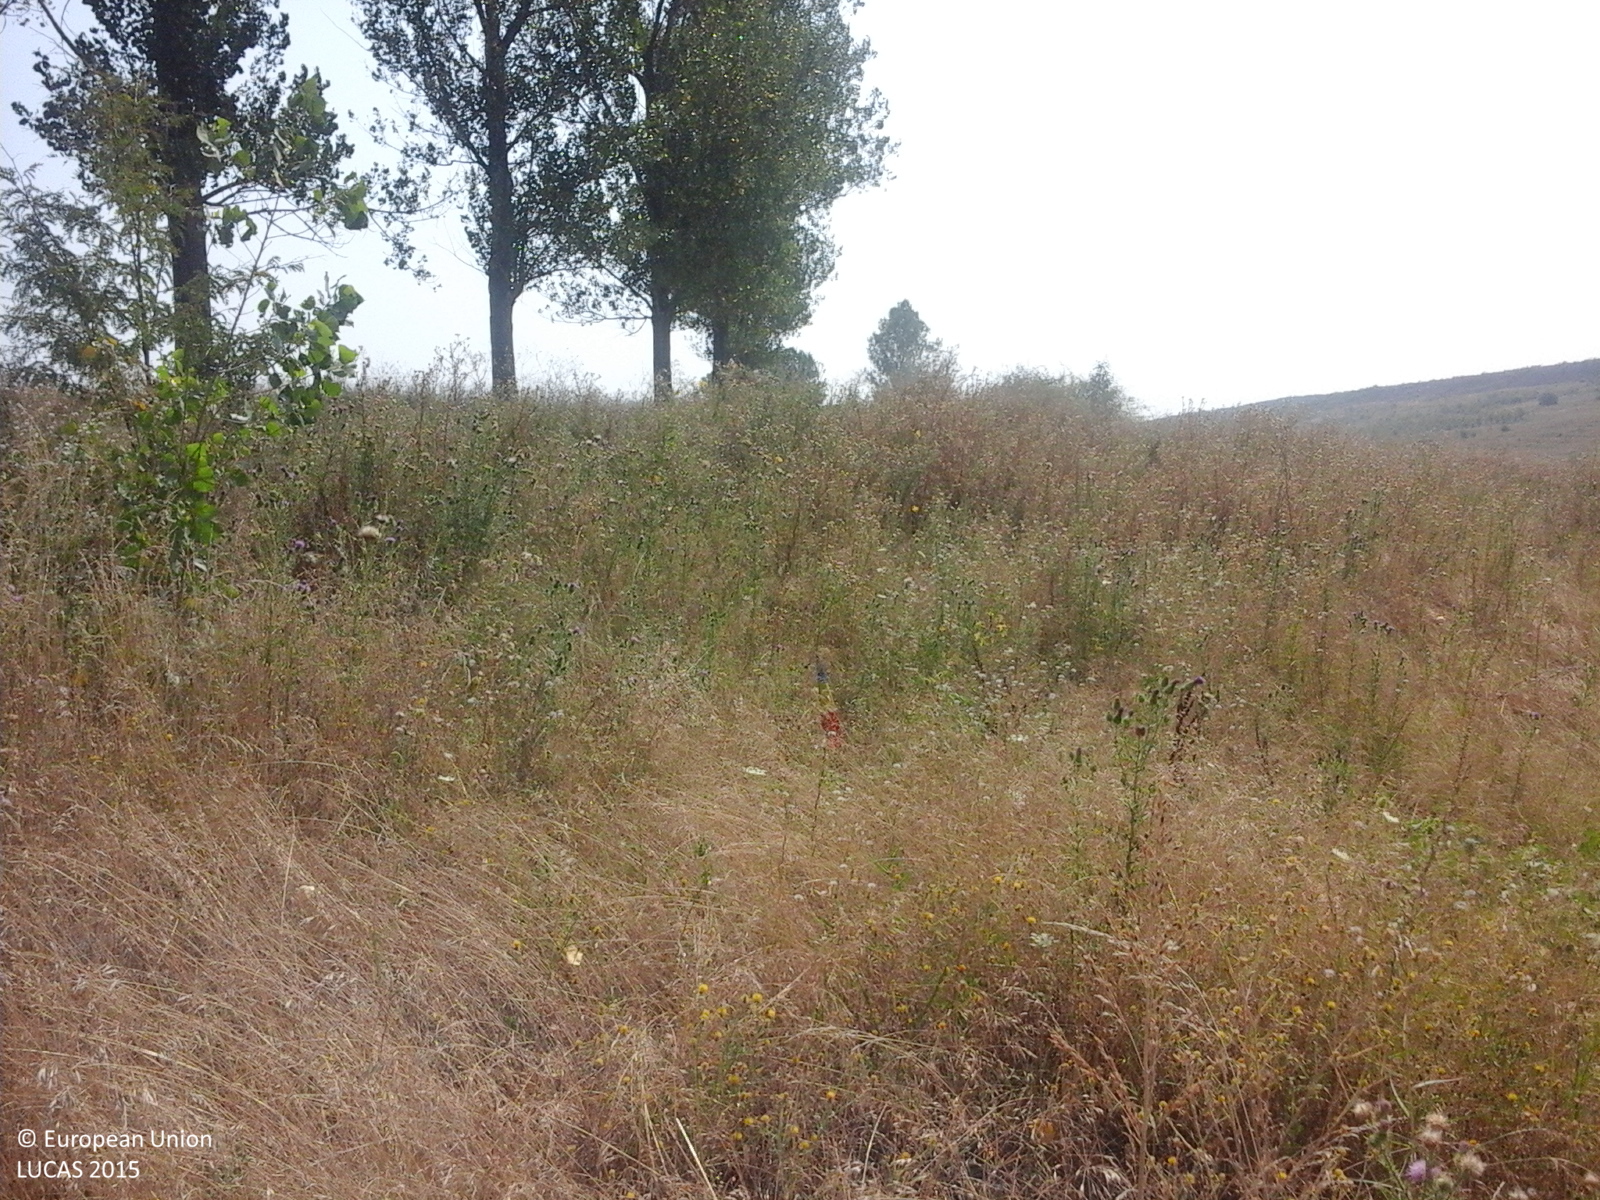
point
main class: Grassland
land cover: Spontaneously vegetated surfaces
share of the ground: > 75 %
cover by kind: herbaceous plants 100 %
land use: Fallow land
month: August
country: RO
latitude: 44.3842
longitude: 23.4446
